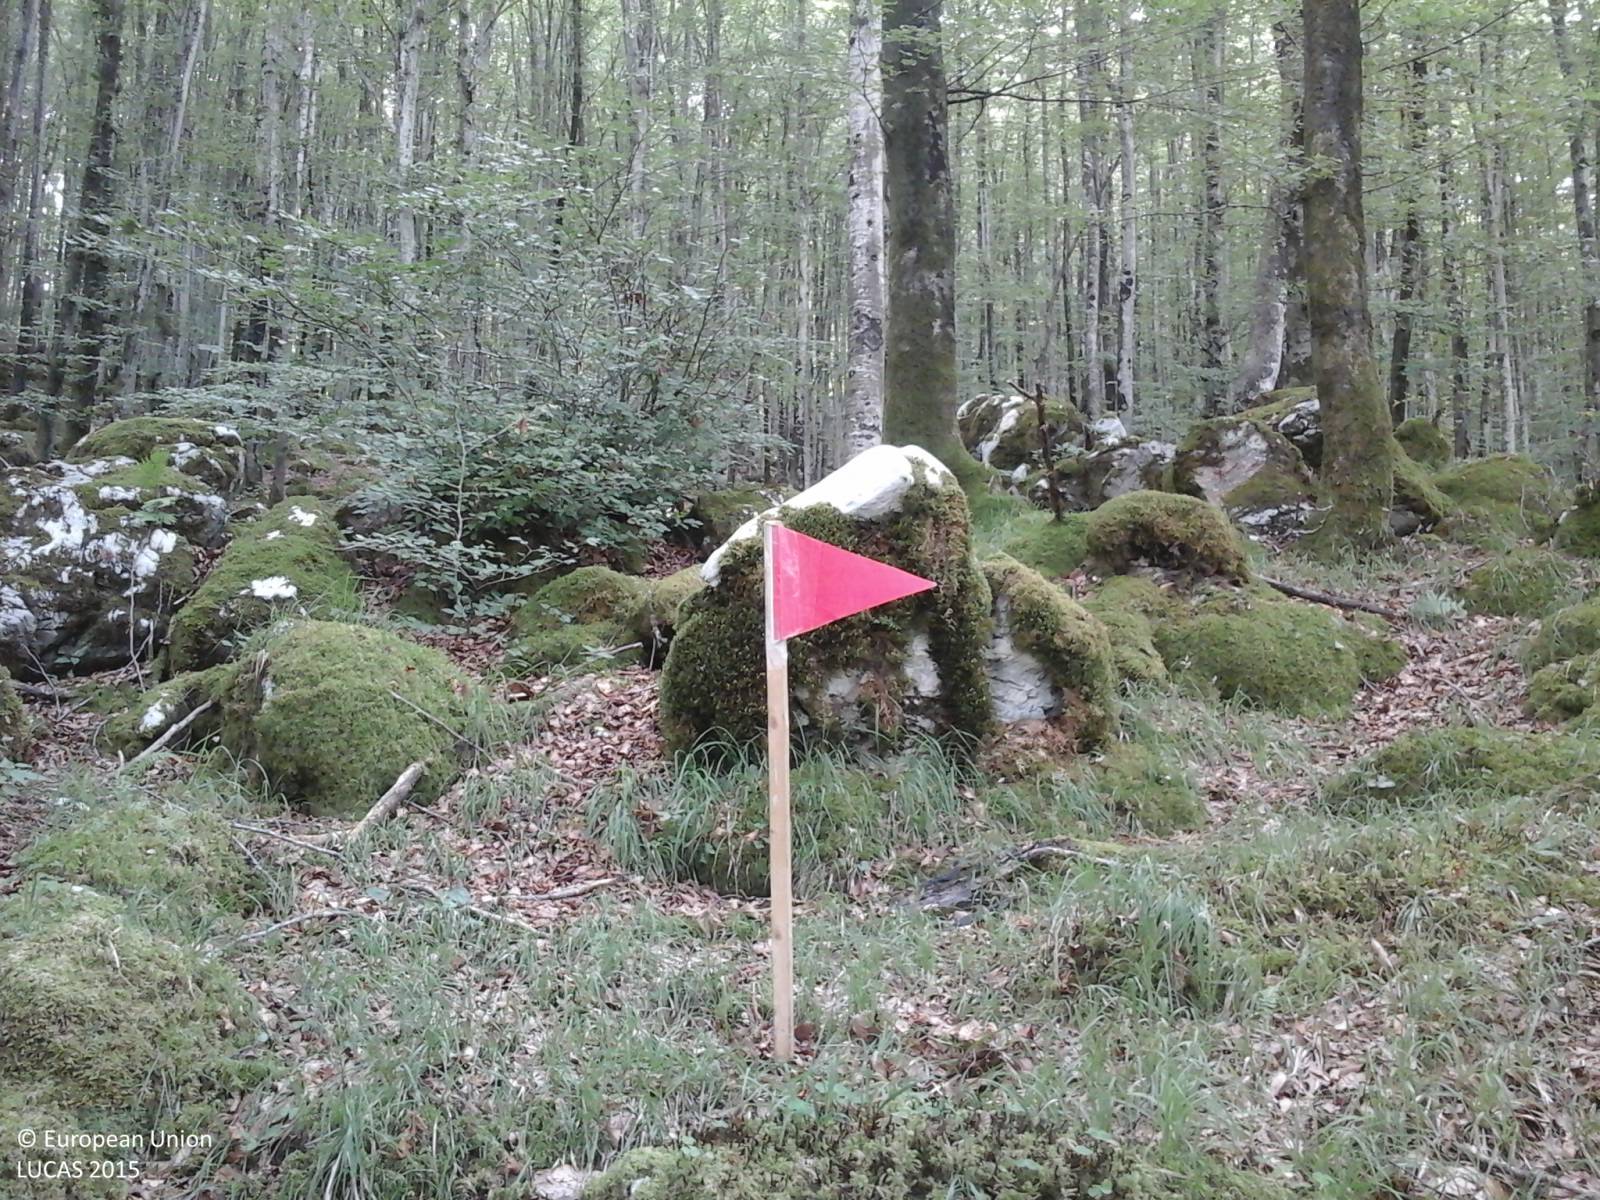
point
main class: Woodland
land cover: Broadleaved woodland
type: mountainous beech forest
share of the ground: > 75 %
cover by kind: broadleaved forest trees 100 %
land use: Forestry
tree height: > 5 m
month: July
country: IT
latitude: 46.1767
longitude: 12.5488
